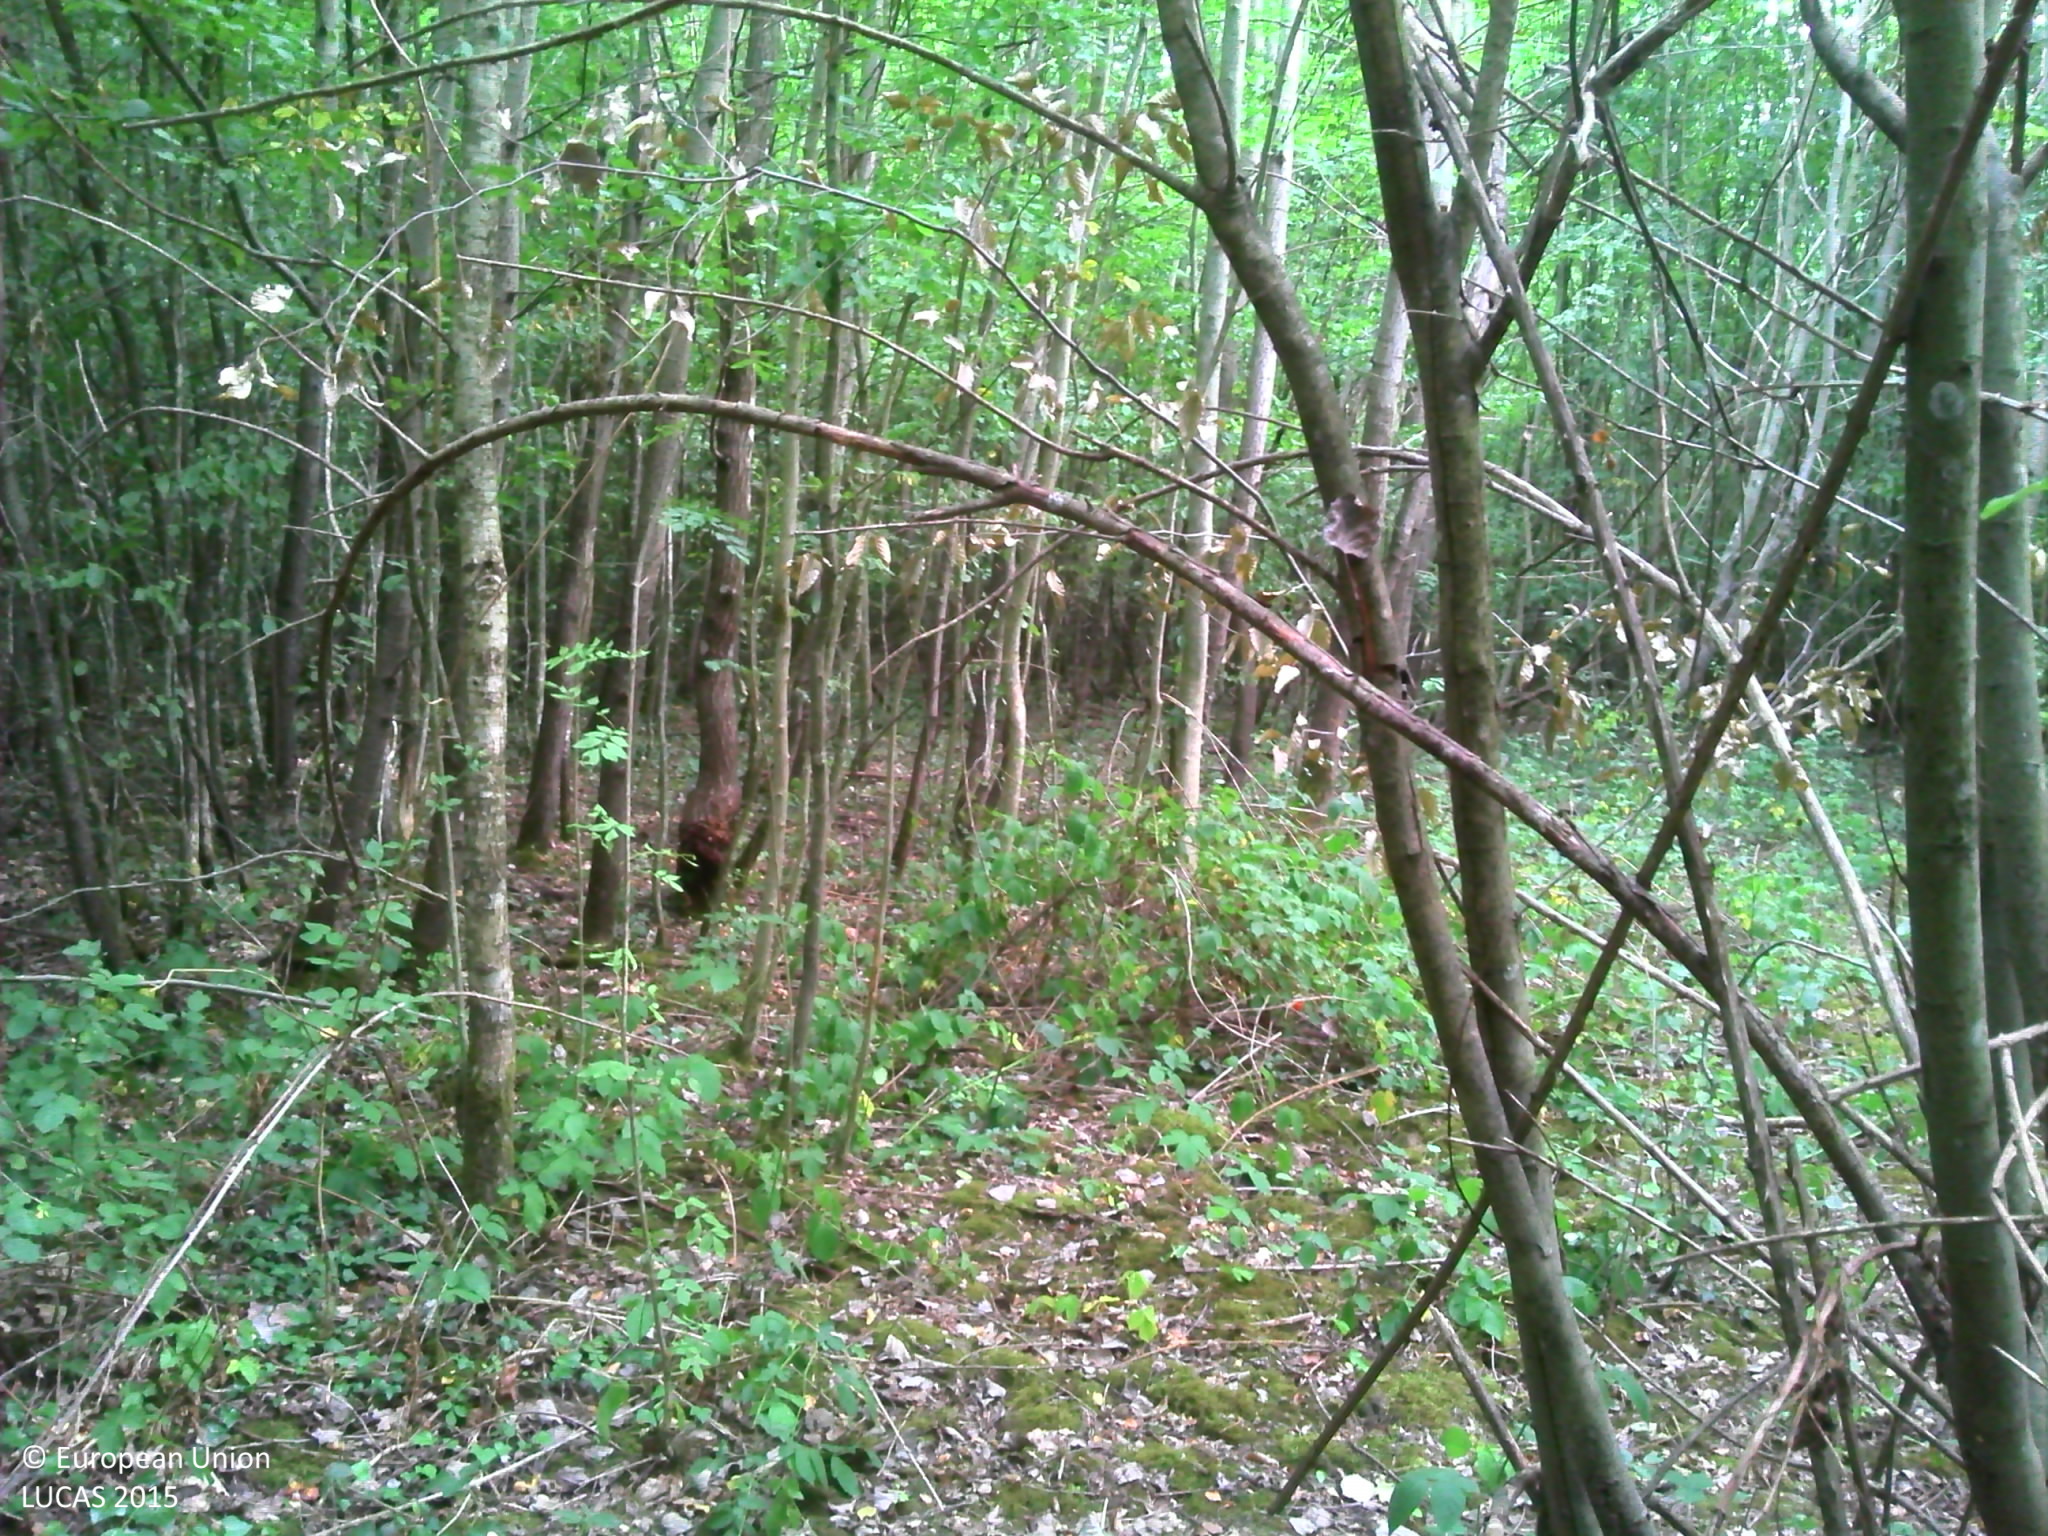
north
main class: Woodland
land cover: Broadleaved woodland
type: beech forest
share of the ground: > 75 %
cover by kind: broadleaved forest trees 50 %, lichens and mosses 20 %, herbaceous plants 10 %, unconsolidated bare surface 10 %
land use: Forestry
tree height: > 5 m
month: August
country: FR
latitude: 48.8860
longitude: 3.2965
